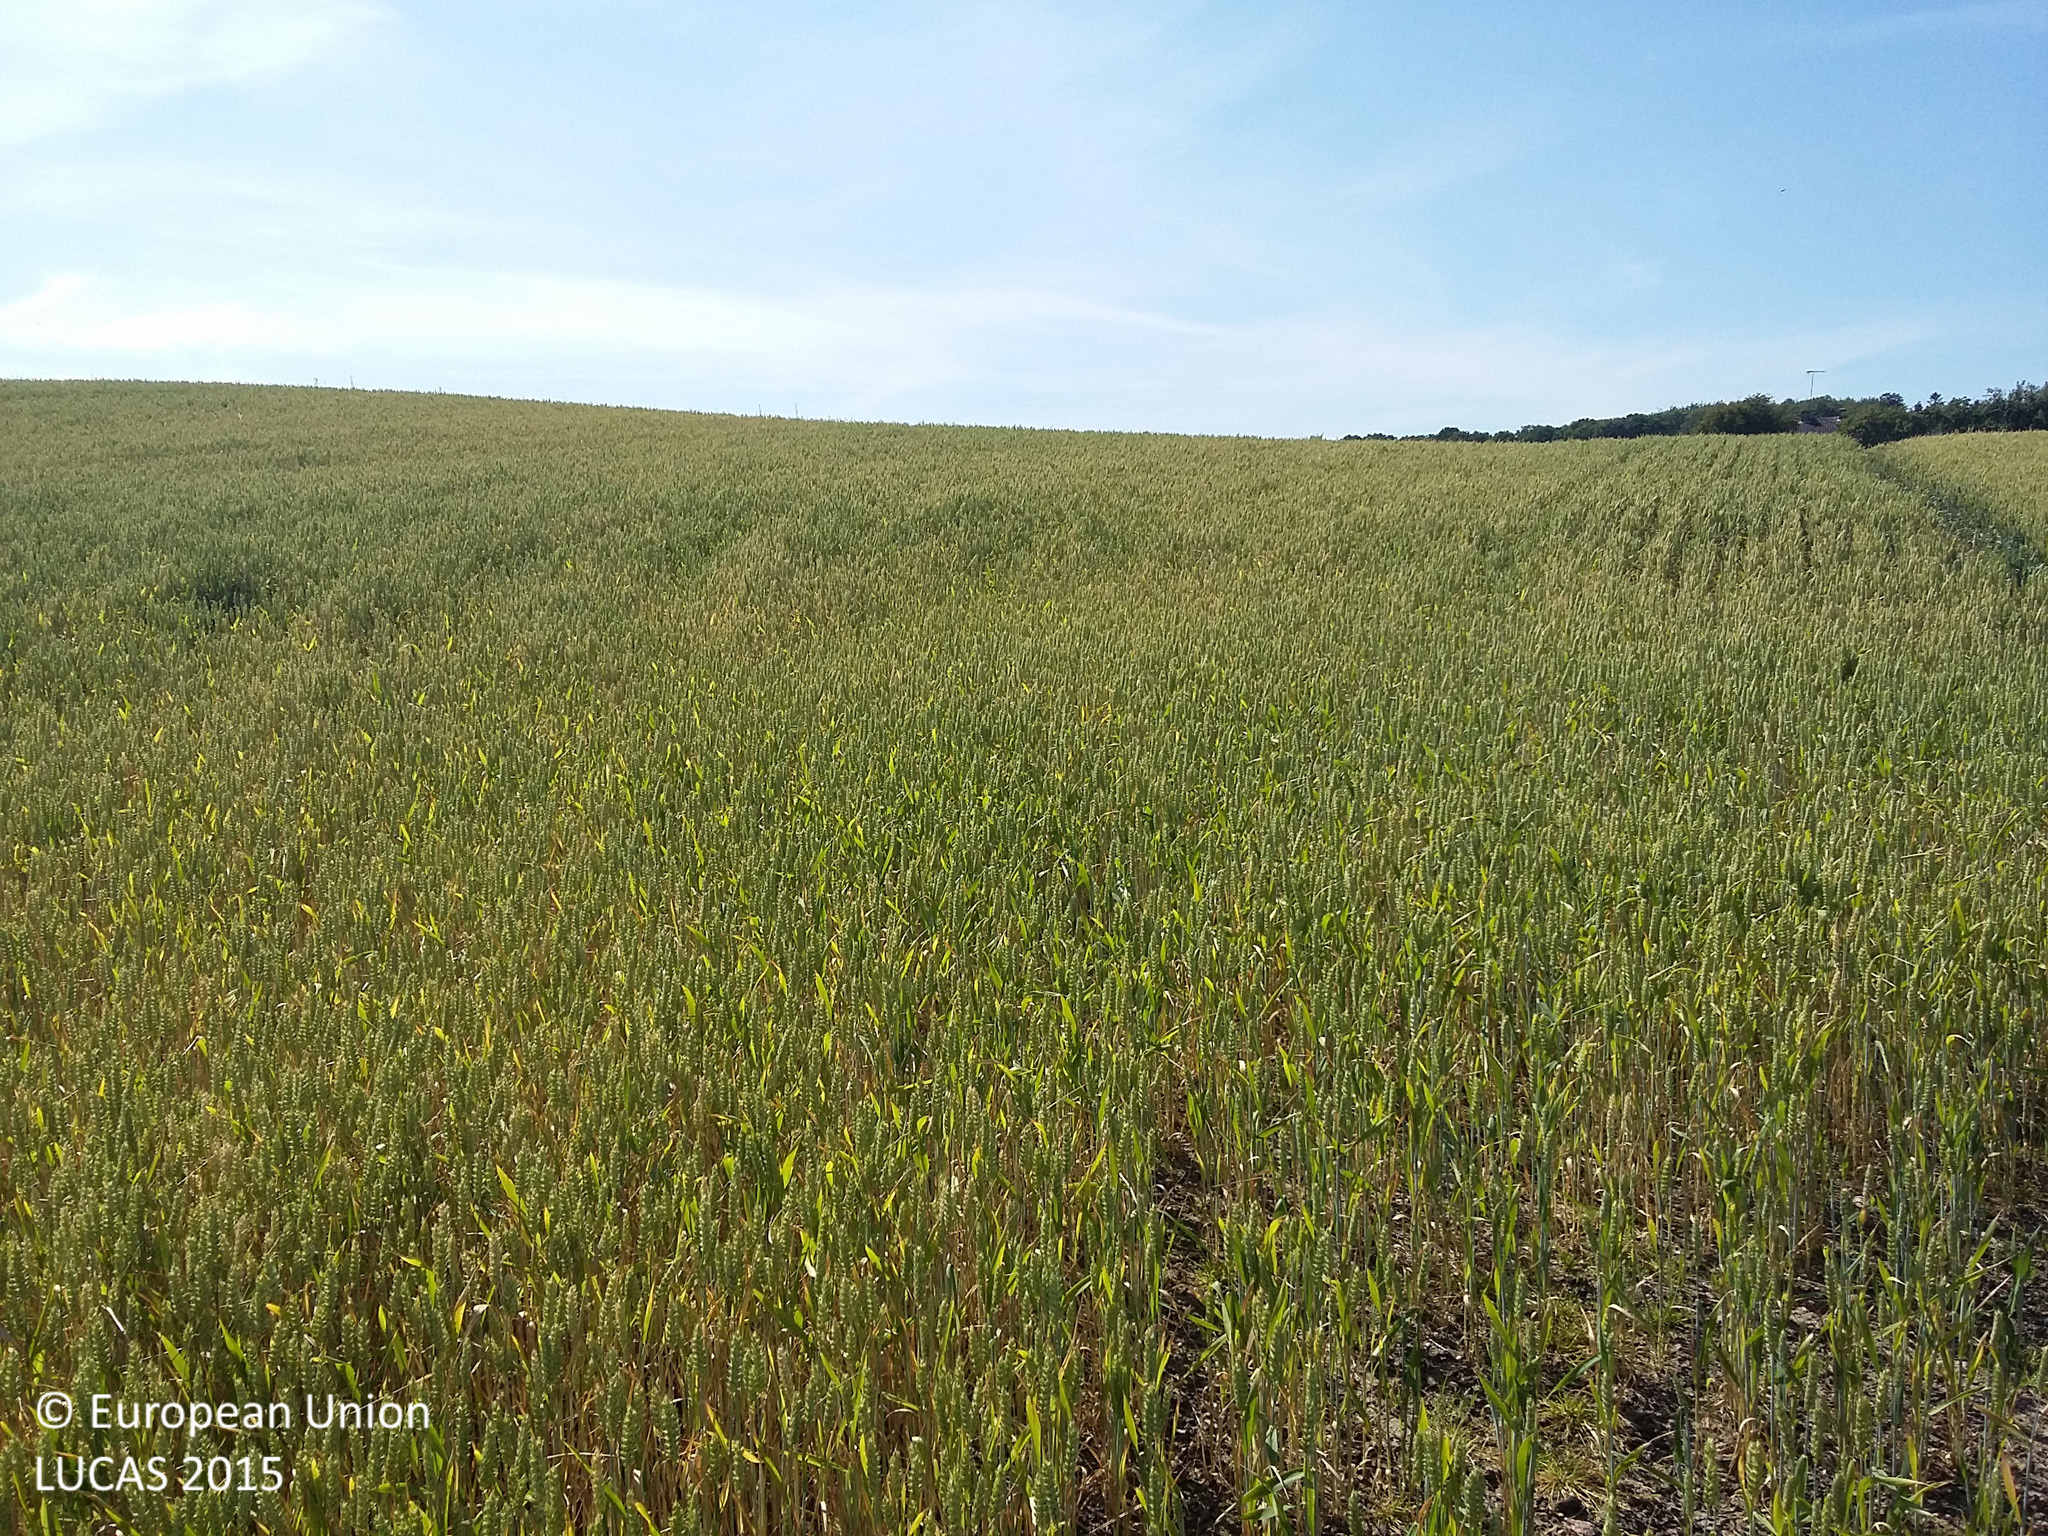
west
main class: Cropland
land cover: Common wheat
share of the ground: > 75 %
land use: Agriculture (excluding fallow land and kitchen gardens)
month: July
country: DK
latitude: 55.6036
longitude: 11.5065
